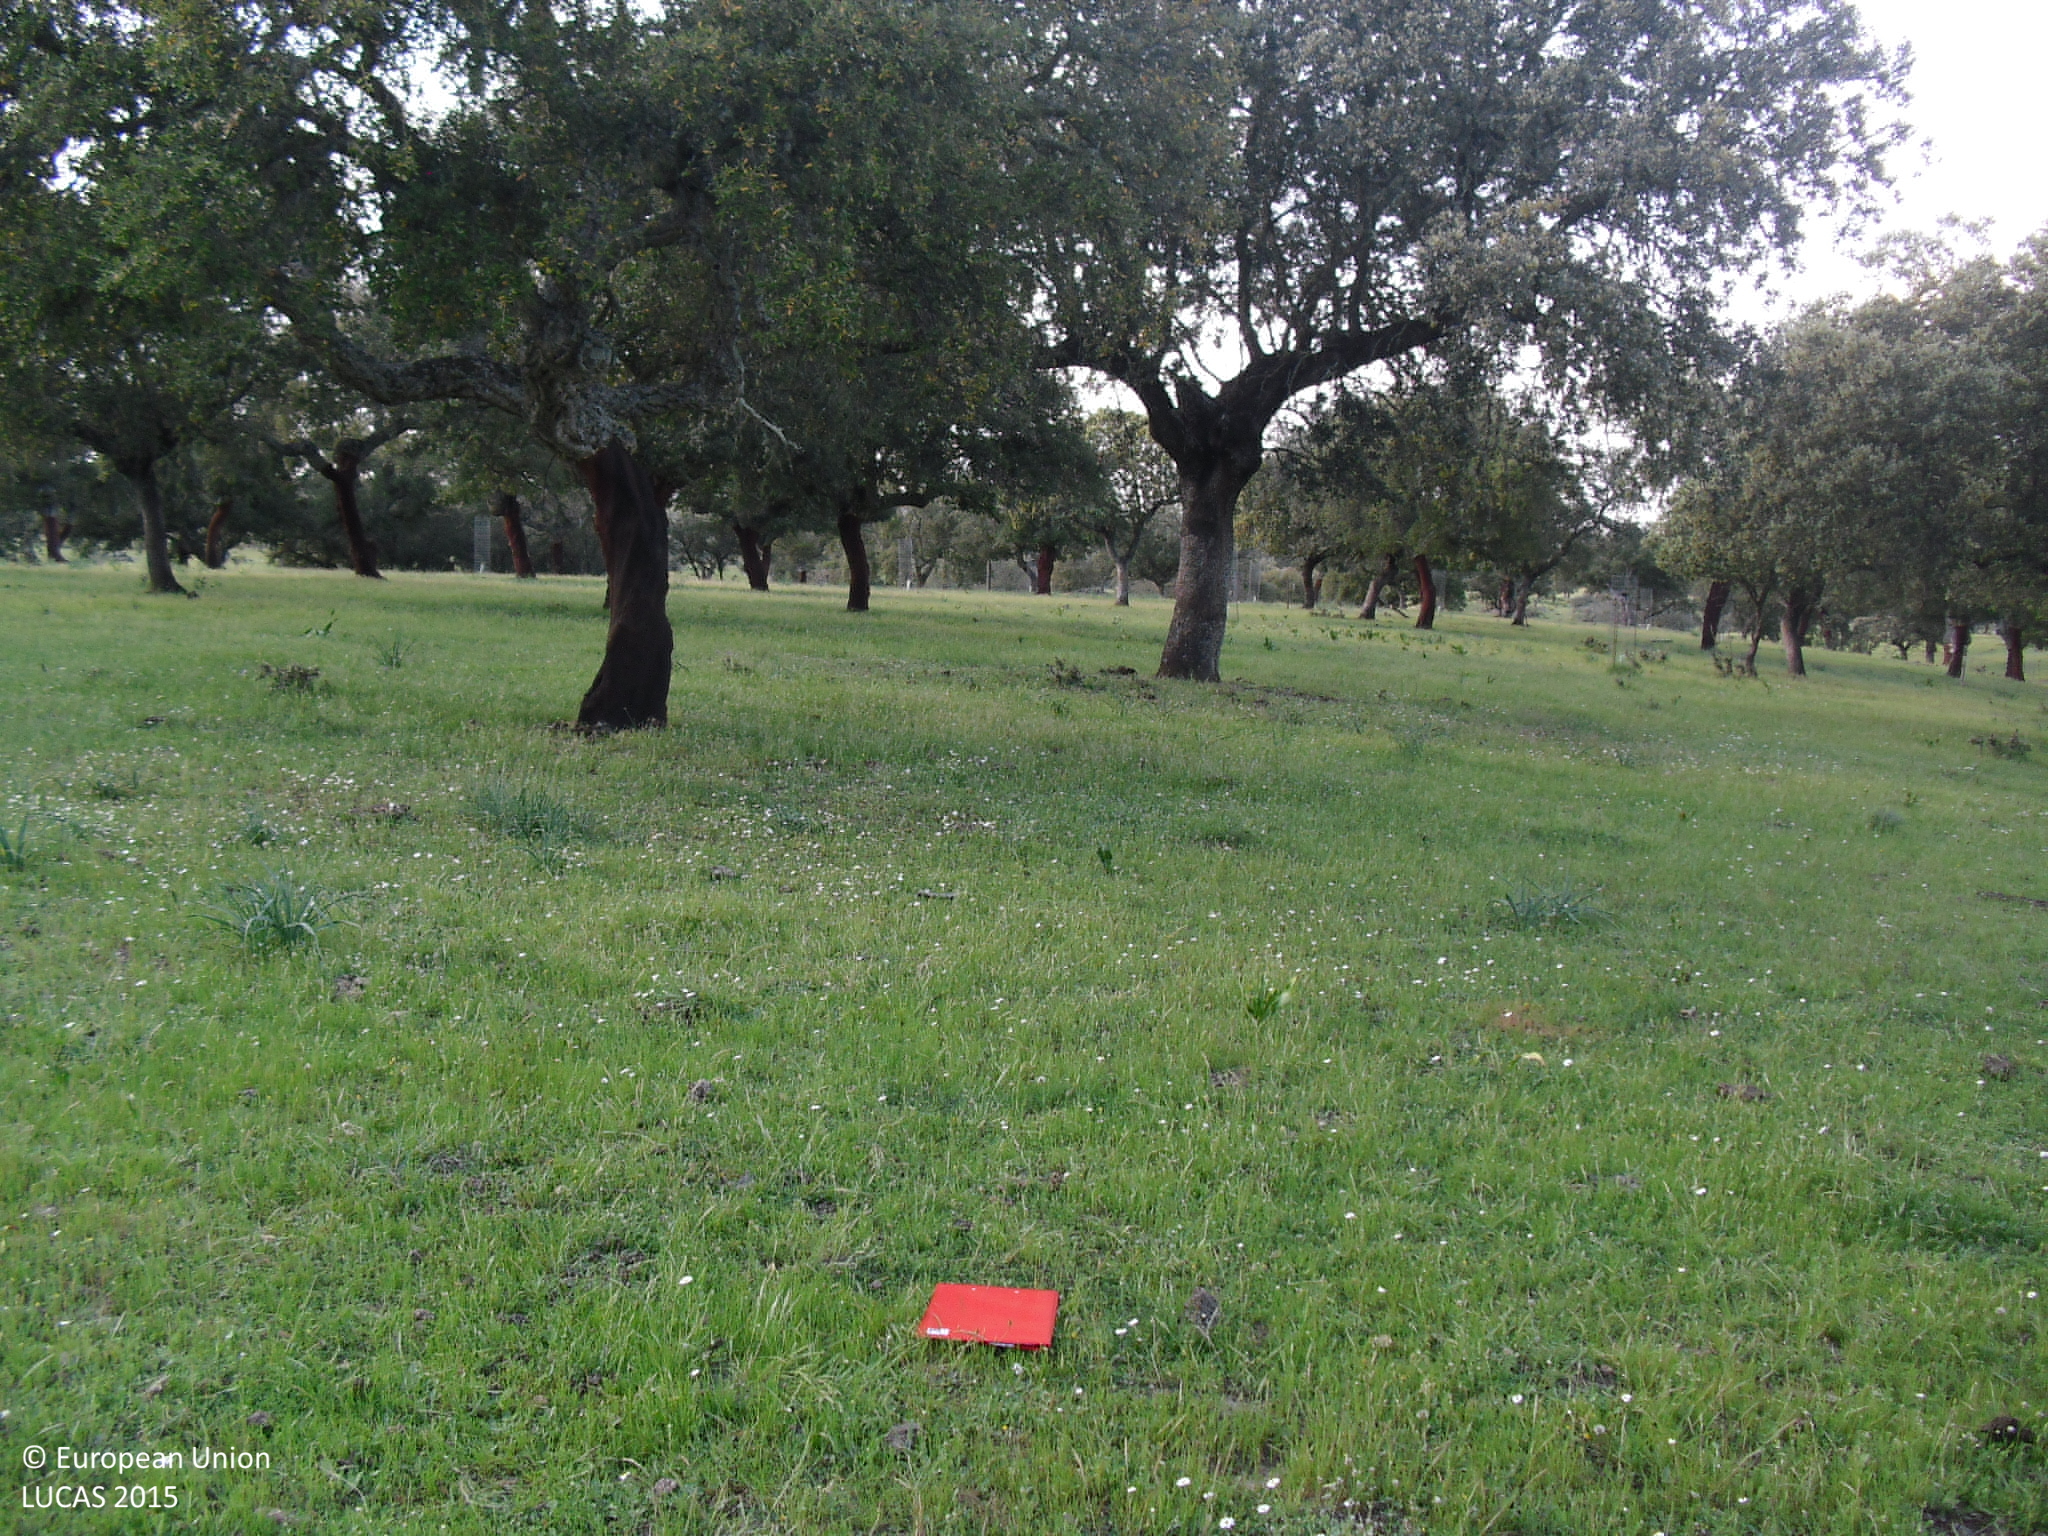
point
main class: Woodland
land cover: Broadleaved woodland
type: broadleaved evergreen forest
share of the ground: > 75 %
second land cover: Grassland without tree/shrub cover
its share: > 75 %
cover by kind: herbaceous plants 85 %, broadleaved forest trees 15 %
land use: Forestry
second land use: Agriculture (excluding fallow land and kitchen gardens)
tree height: > 5 m
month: April
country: ES
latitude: 39.3821
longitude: -6.5673
